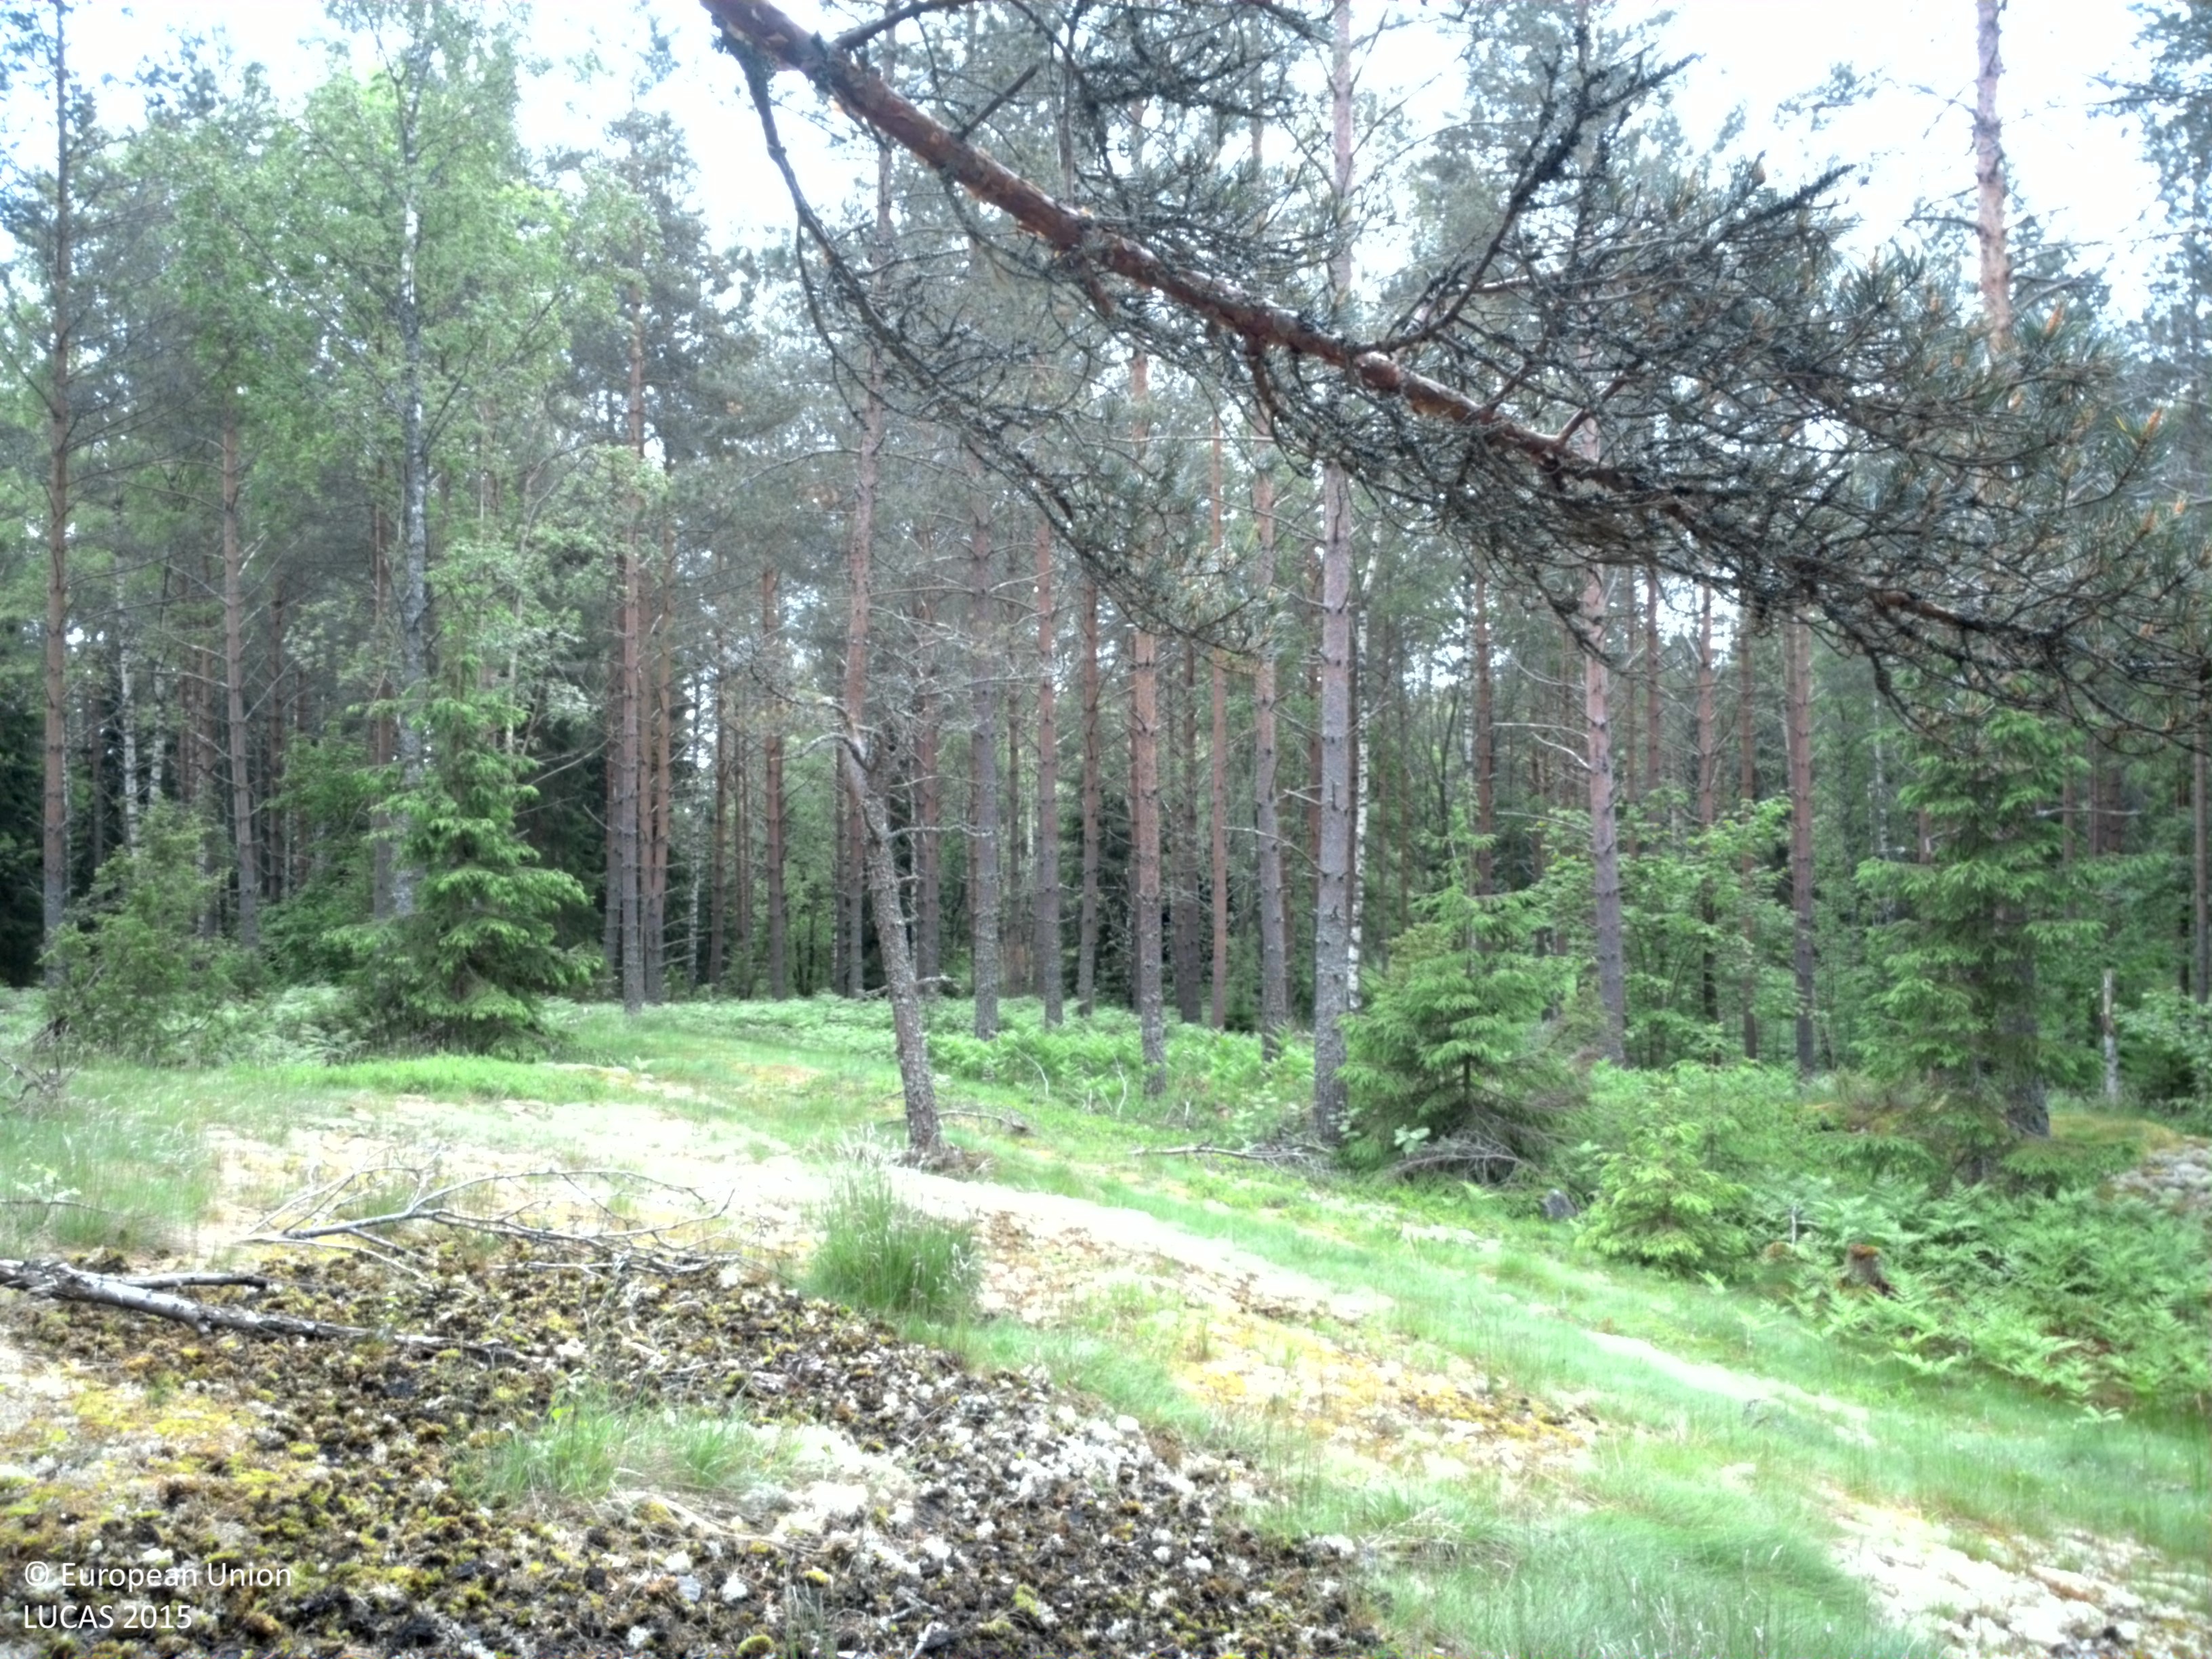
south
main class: Woodland
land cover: Pine dominated coniferous woodland
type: boreal forest
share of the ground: 10 - 25 %
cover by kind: herbaceous plants 25 %, lichens and mosses 25 %, consolidated bare surface 25 %, coniferous forest trees 20 %, broadleaved forest trees 5 %
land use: Forestry
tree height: > 5 m
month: June
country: SE
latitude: 59.6993
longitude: 18.6178
